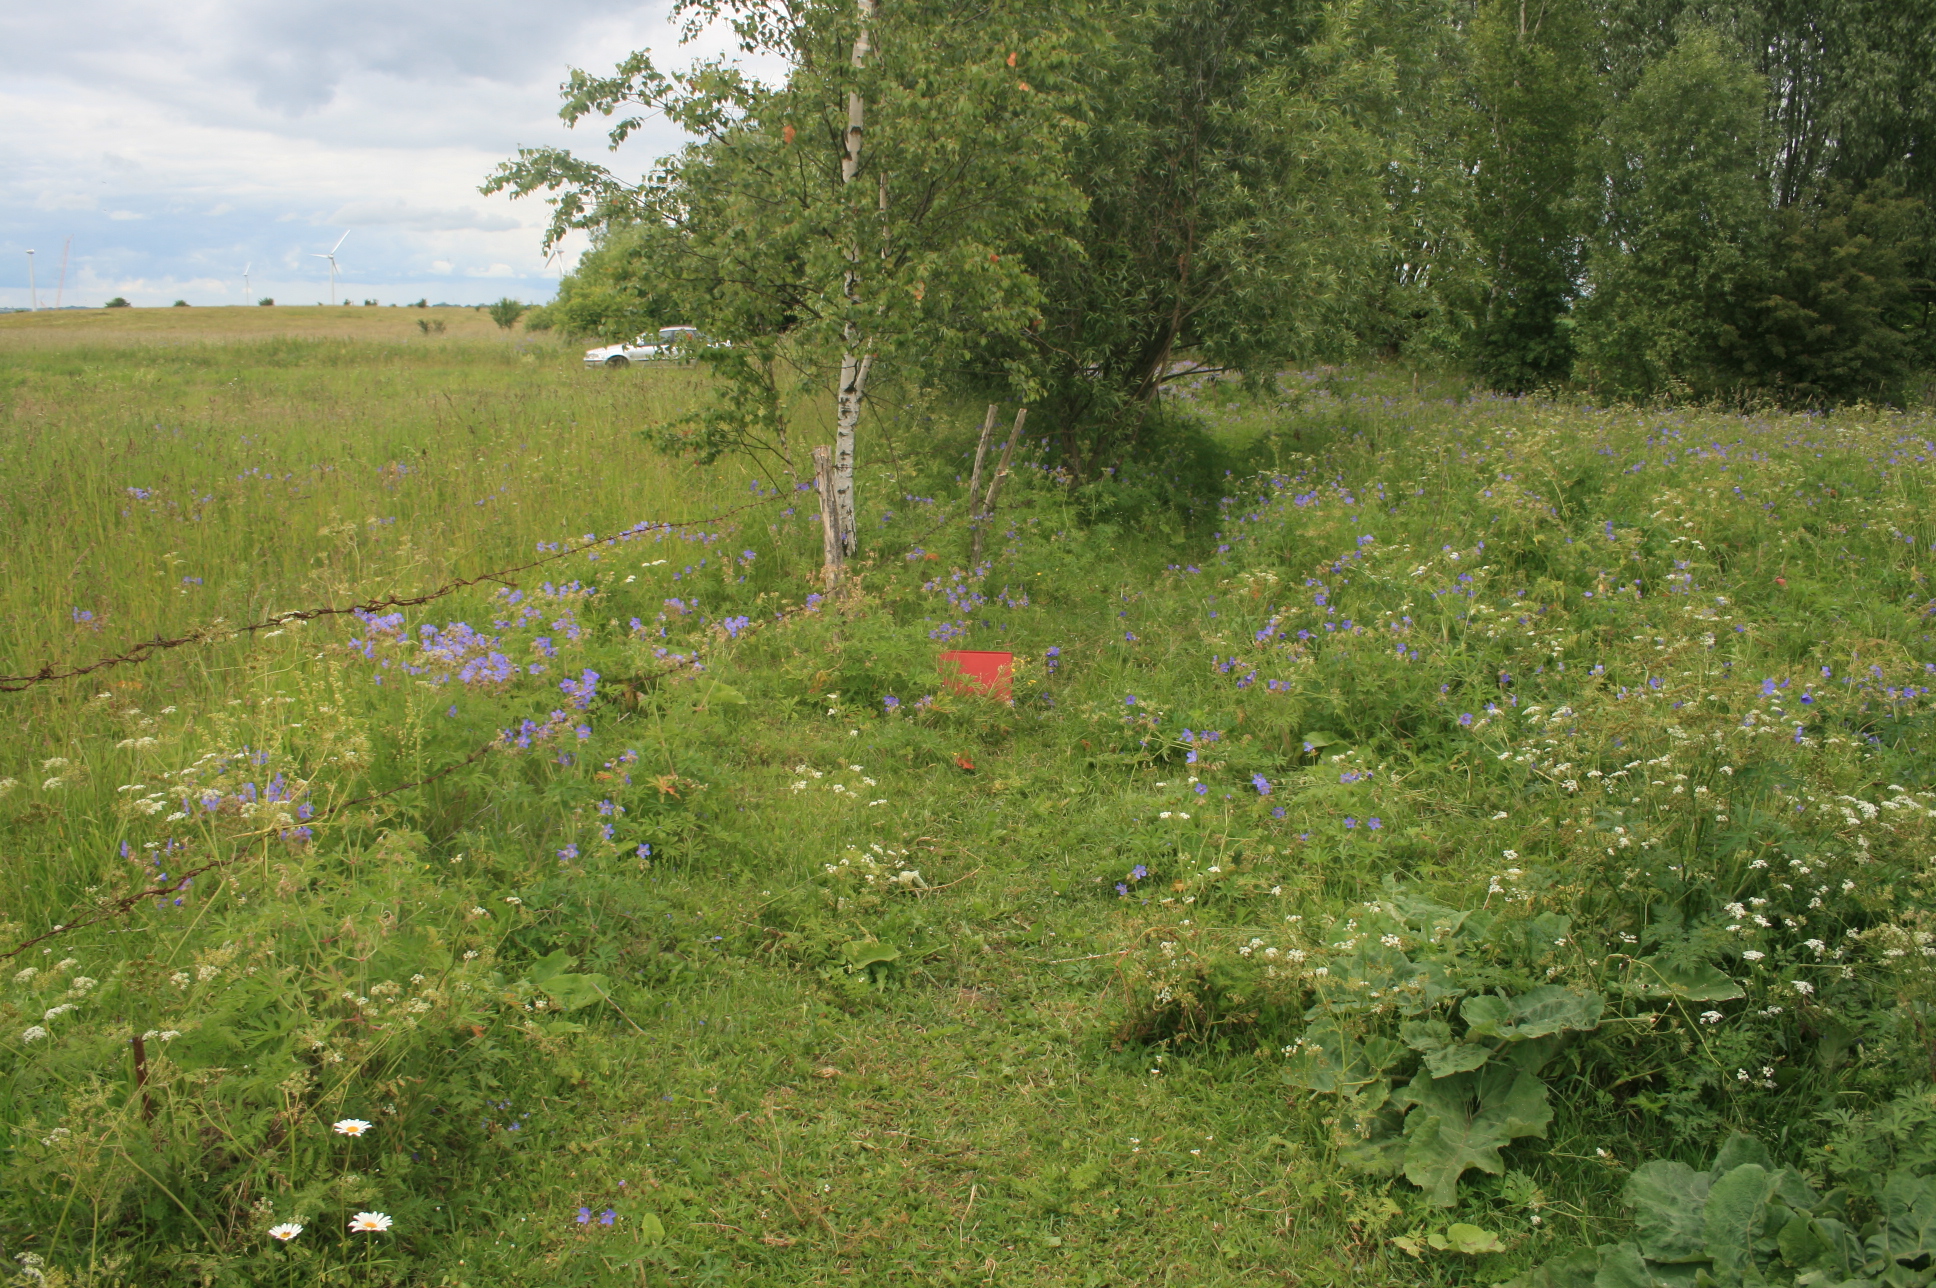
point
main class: Grassland
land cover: Spontaneously vegetated surfaces
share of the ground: > 75 %
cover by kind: herbaceous plants 100 %
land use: Agriculture (excluding fallow land and kitchen gardens)
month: June
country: LT
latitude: 55.1612
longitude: 22.0626
